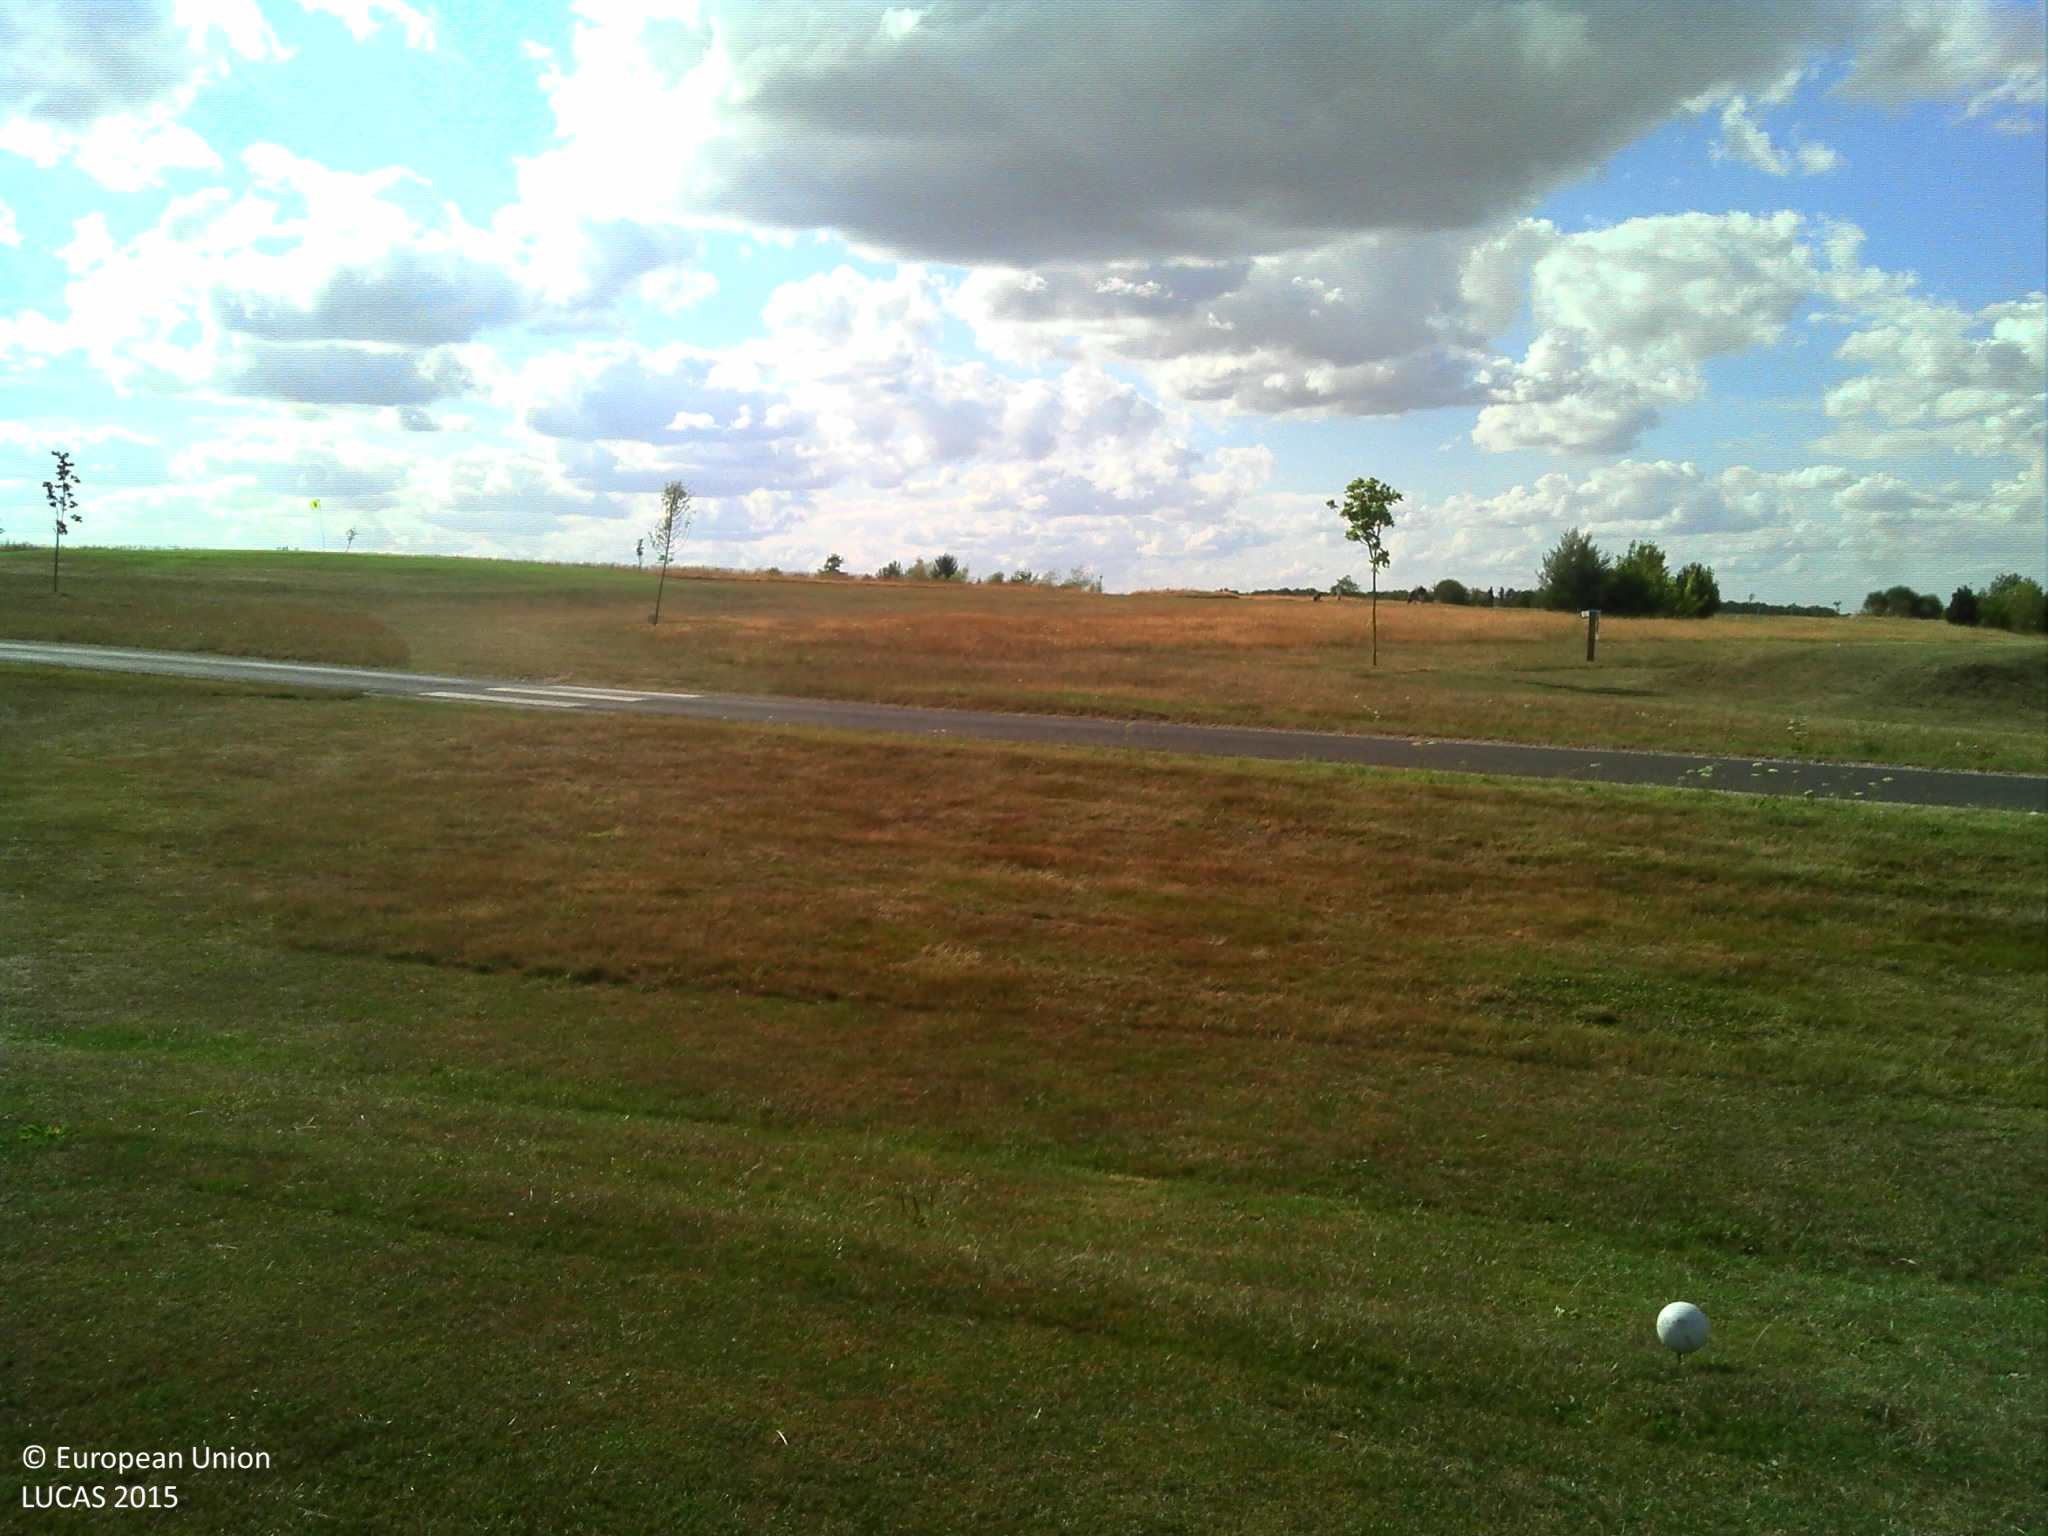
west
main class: Grassland
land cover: Grassland without tree/shrub cover
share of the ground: > 75 %
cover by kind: herbaceous plants 100 %
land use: Sport
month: July
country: FR
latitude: 48.5956
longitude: 1.2080
